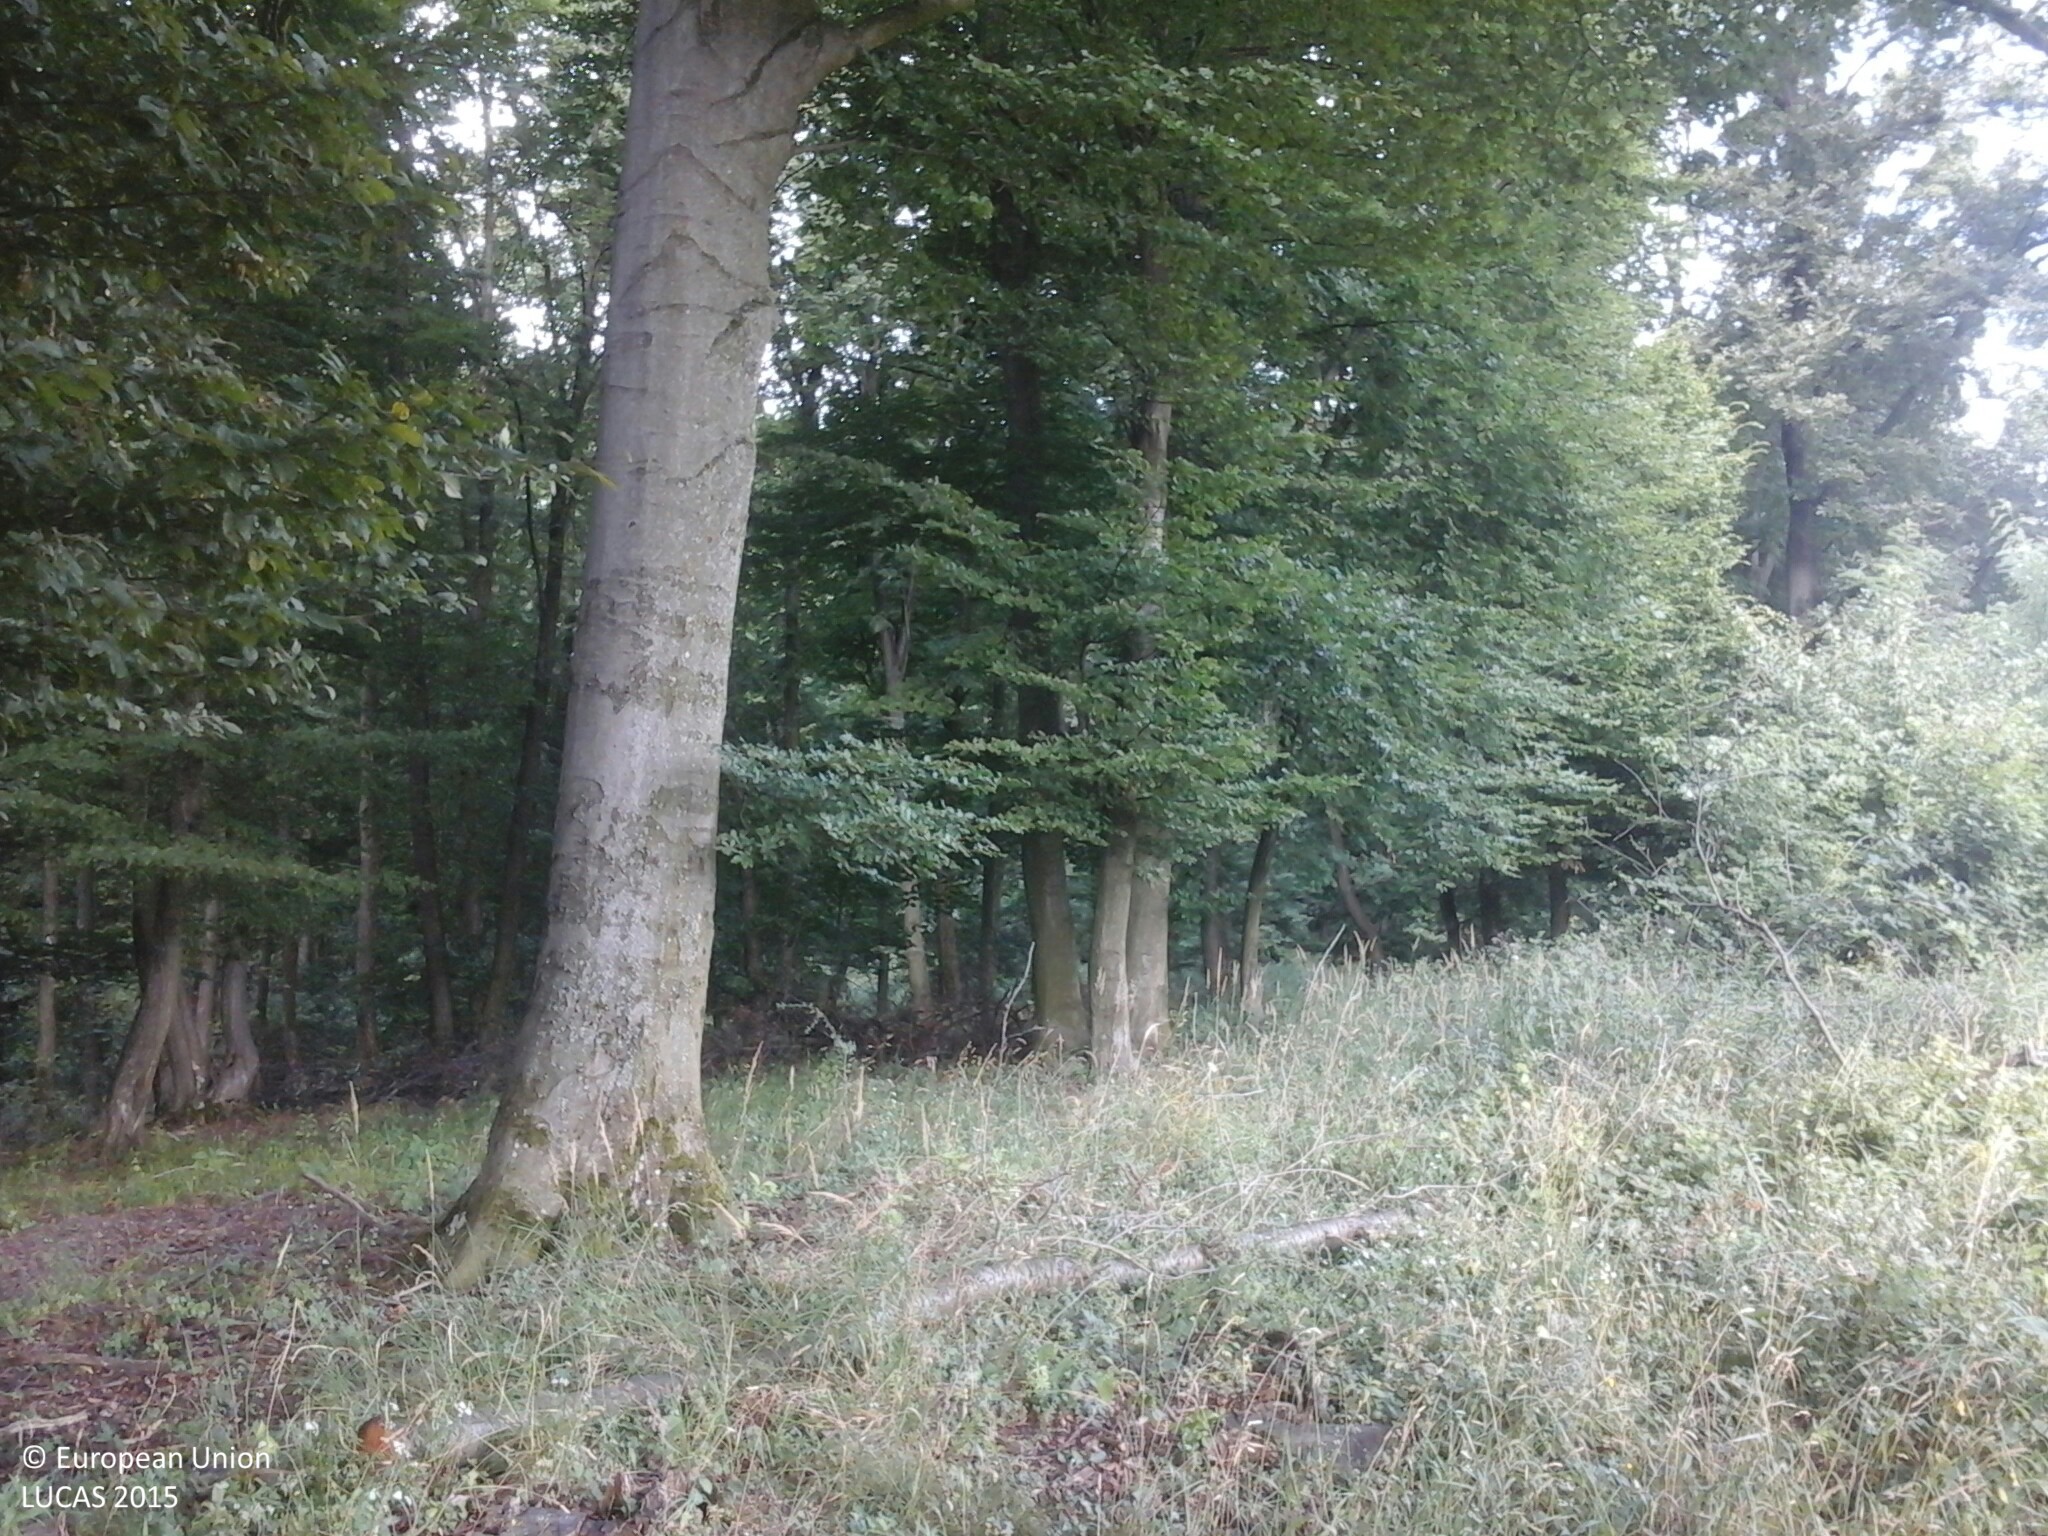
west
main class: Grassland
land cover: Grassland without tree/shrub cover
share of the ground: > 75 %
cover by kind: herbaceous plants 100 %
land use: Agriculture (excluding fallow land and kitchen gardens)
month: July
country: HU
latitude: 47.3582
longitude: 17.9405
